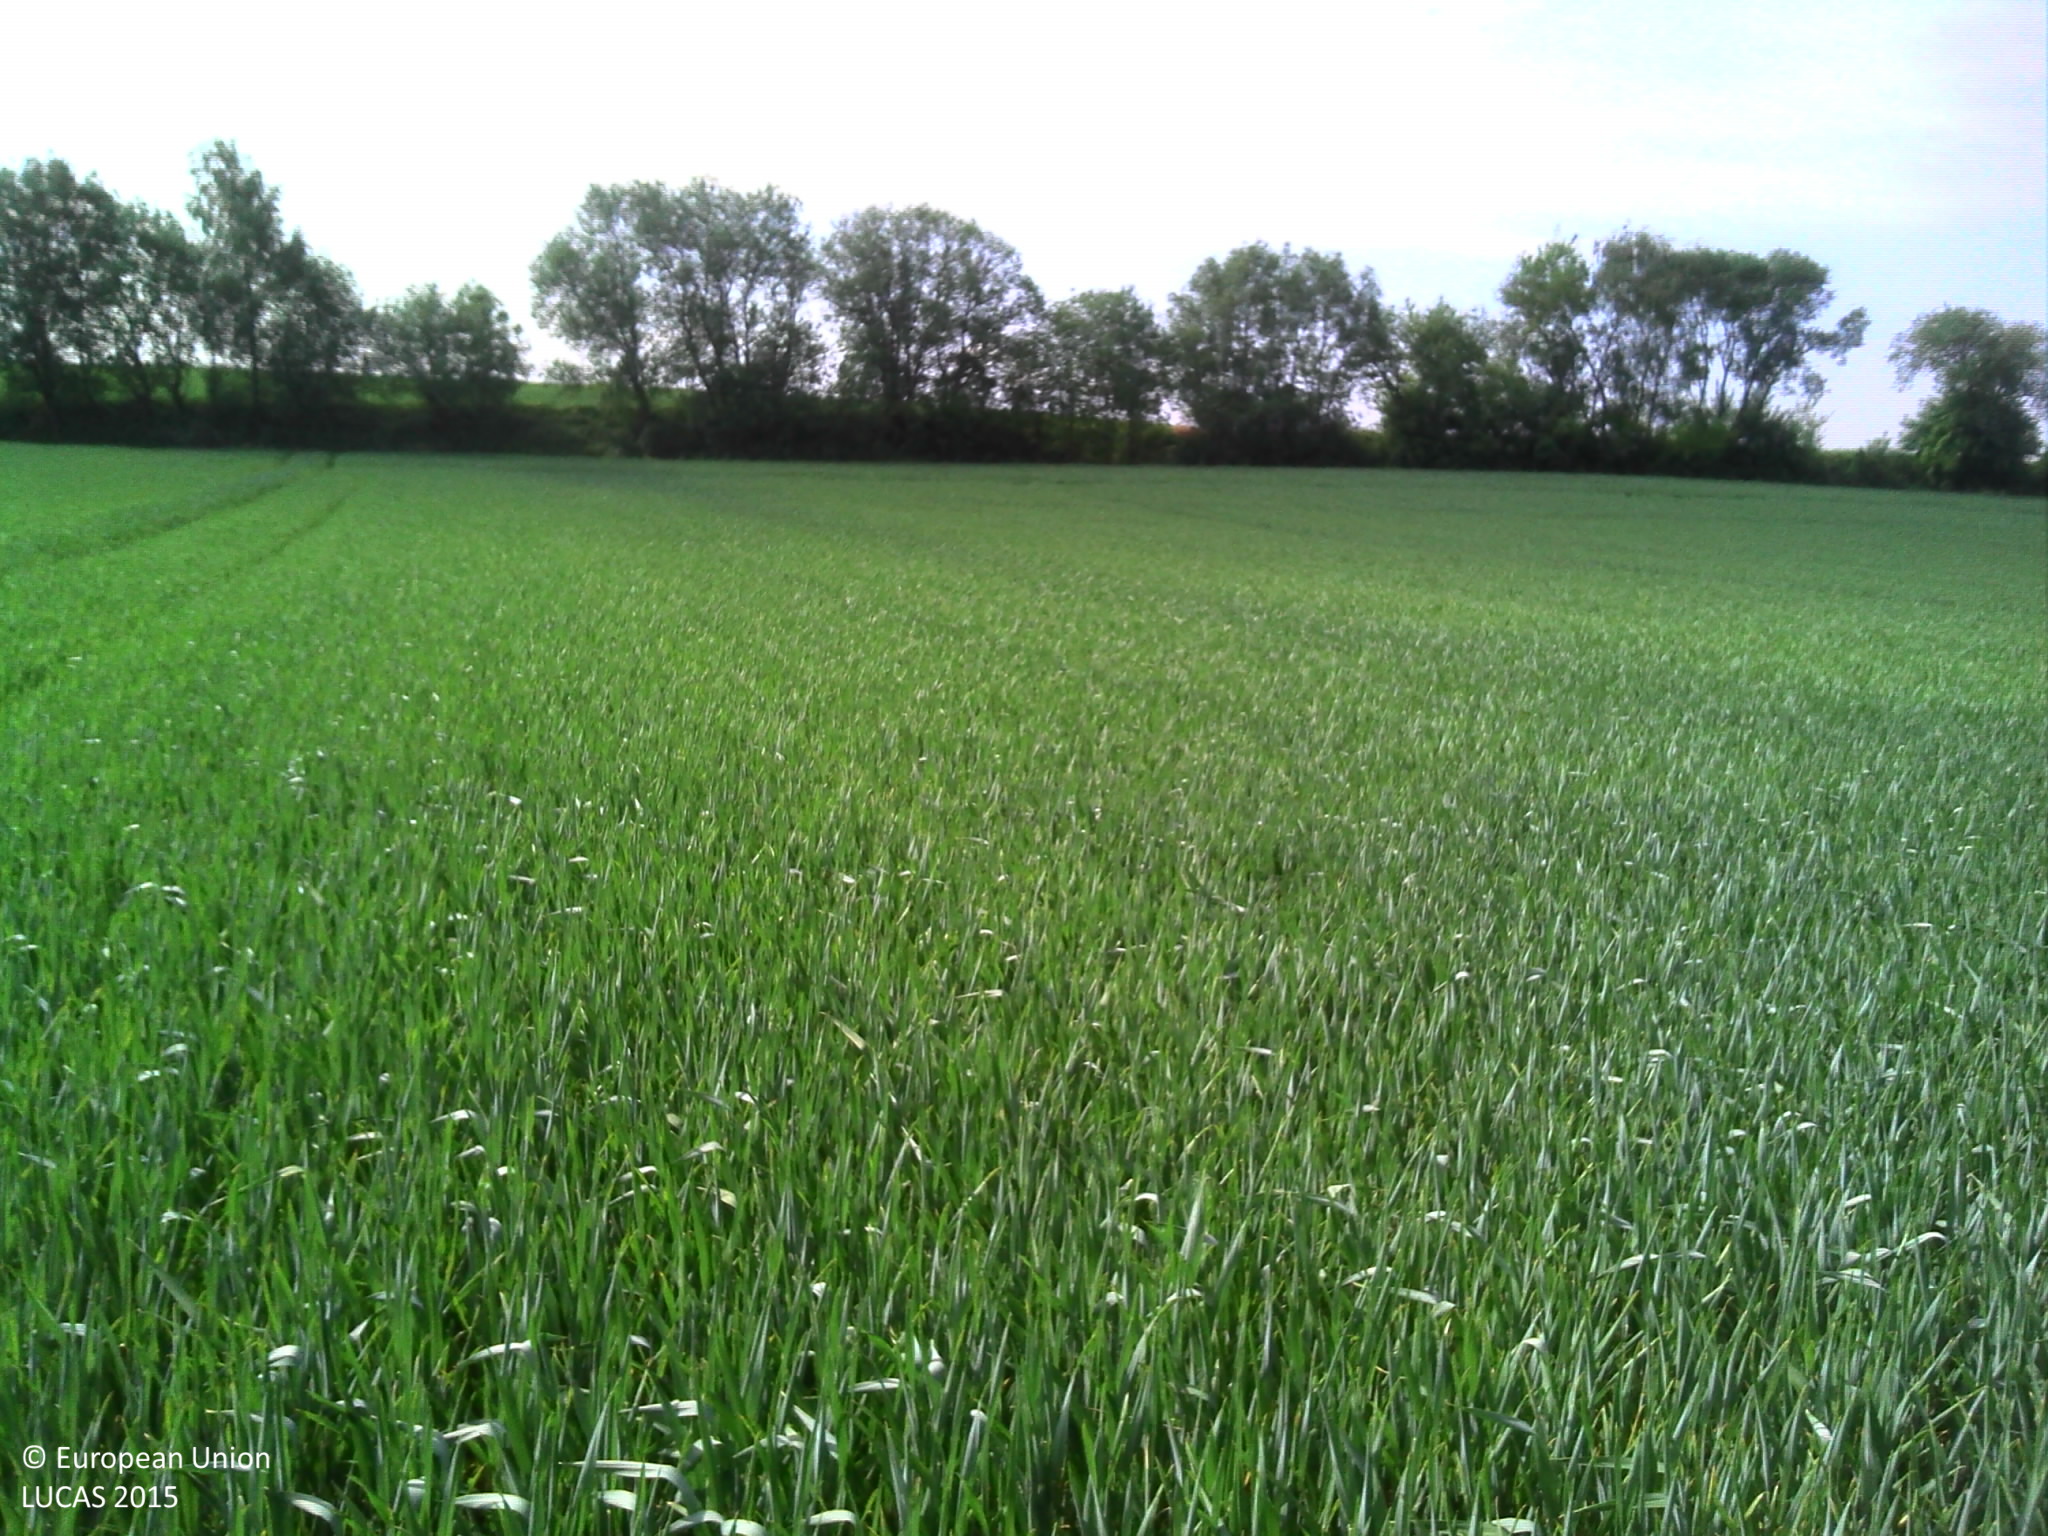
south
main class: Cropland
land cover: Common wheat
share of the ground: > 75 %
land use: Agriculture (excluding fallow land and kitchen gardens)
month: May
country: BE
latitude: 50.5784
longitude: 4.5874
